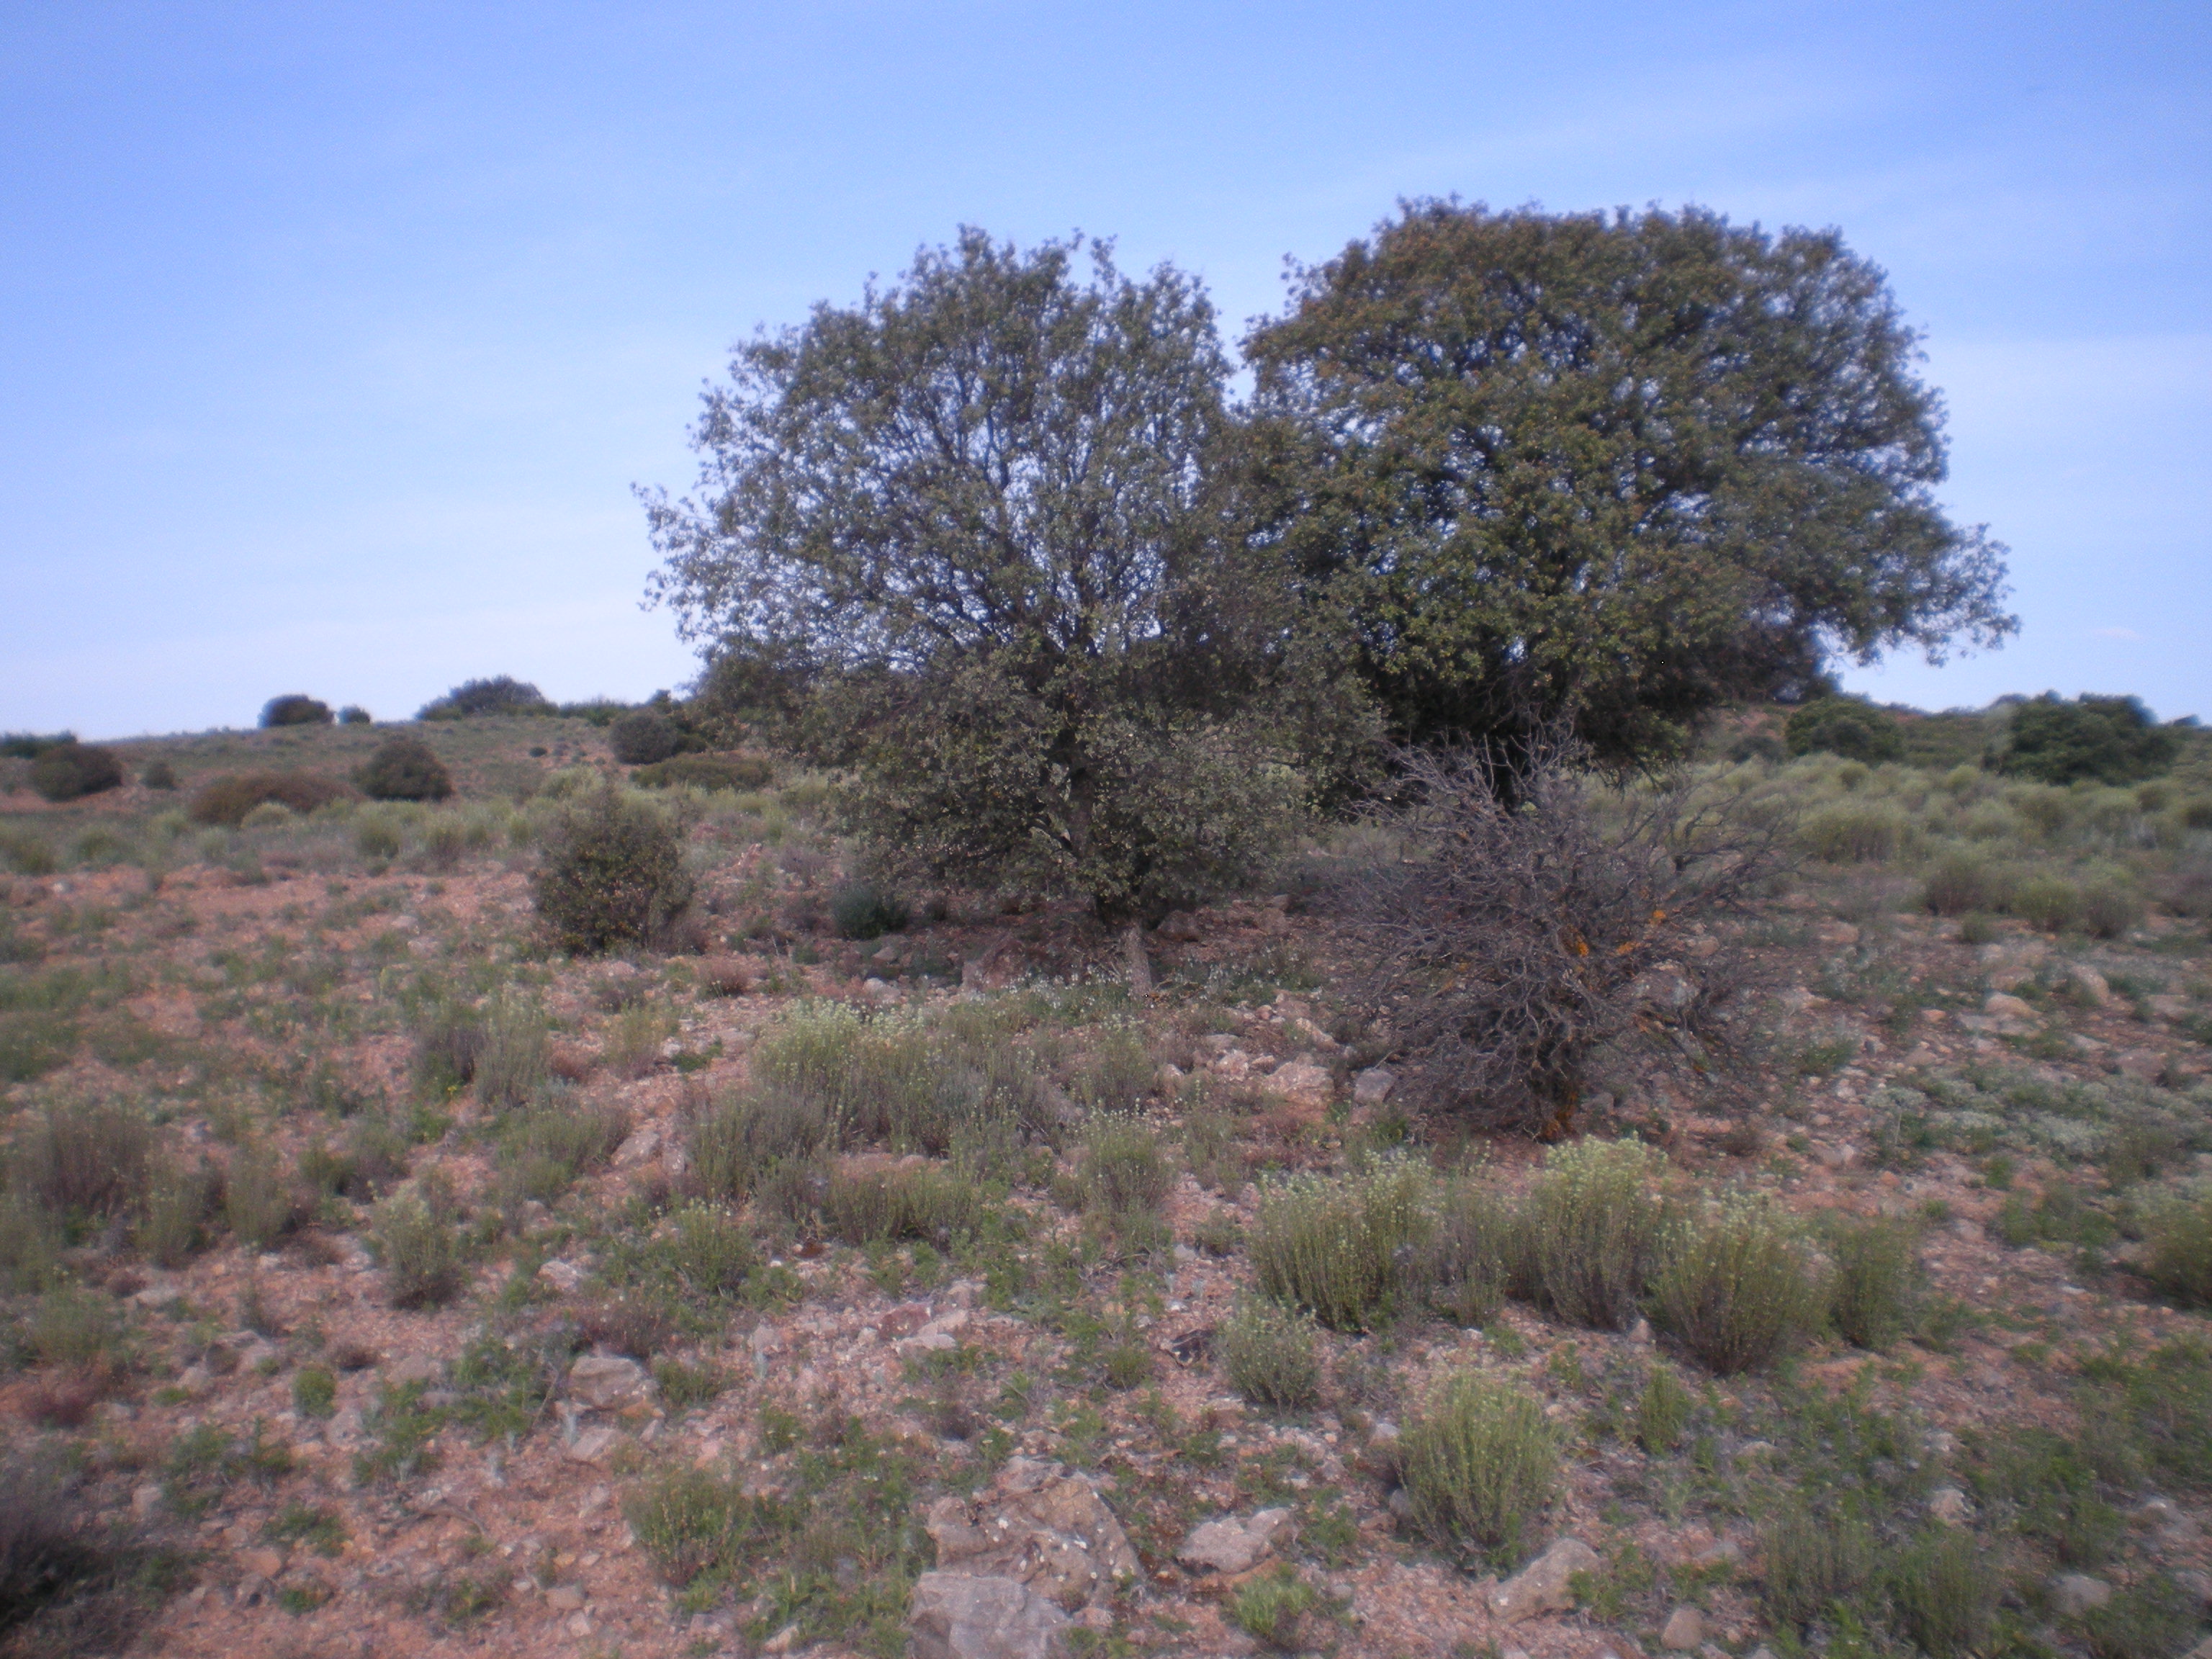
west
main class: Shrubland
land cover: Shrubland with sparse tree cover
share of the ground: 25 - 50 %
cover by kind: unconsolidated bare surface 40 %, herbaceous plants 35 %, shrubs 20 %, broadleaved forest trees 5 %
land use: Semi-natural and natural areas not in use
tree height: < 5 m
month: May
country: ES
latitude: 39.0018
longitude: -2.9541
